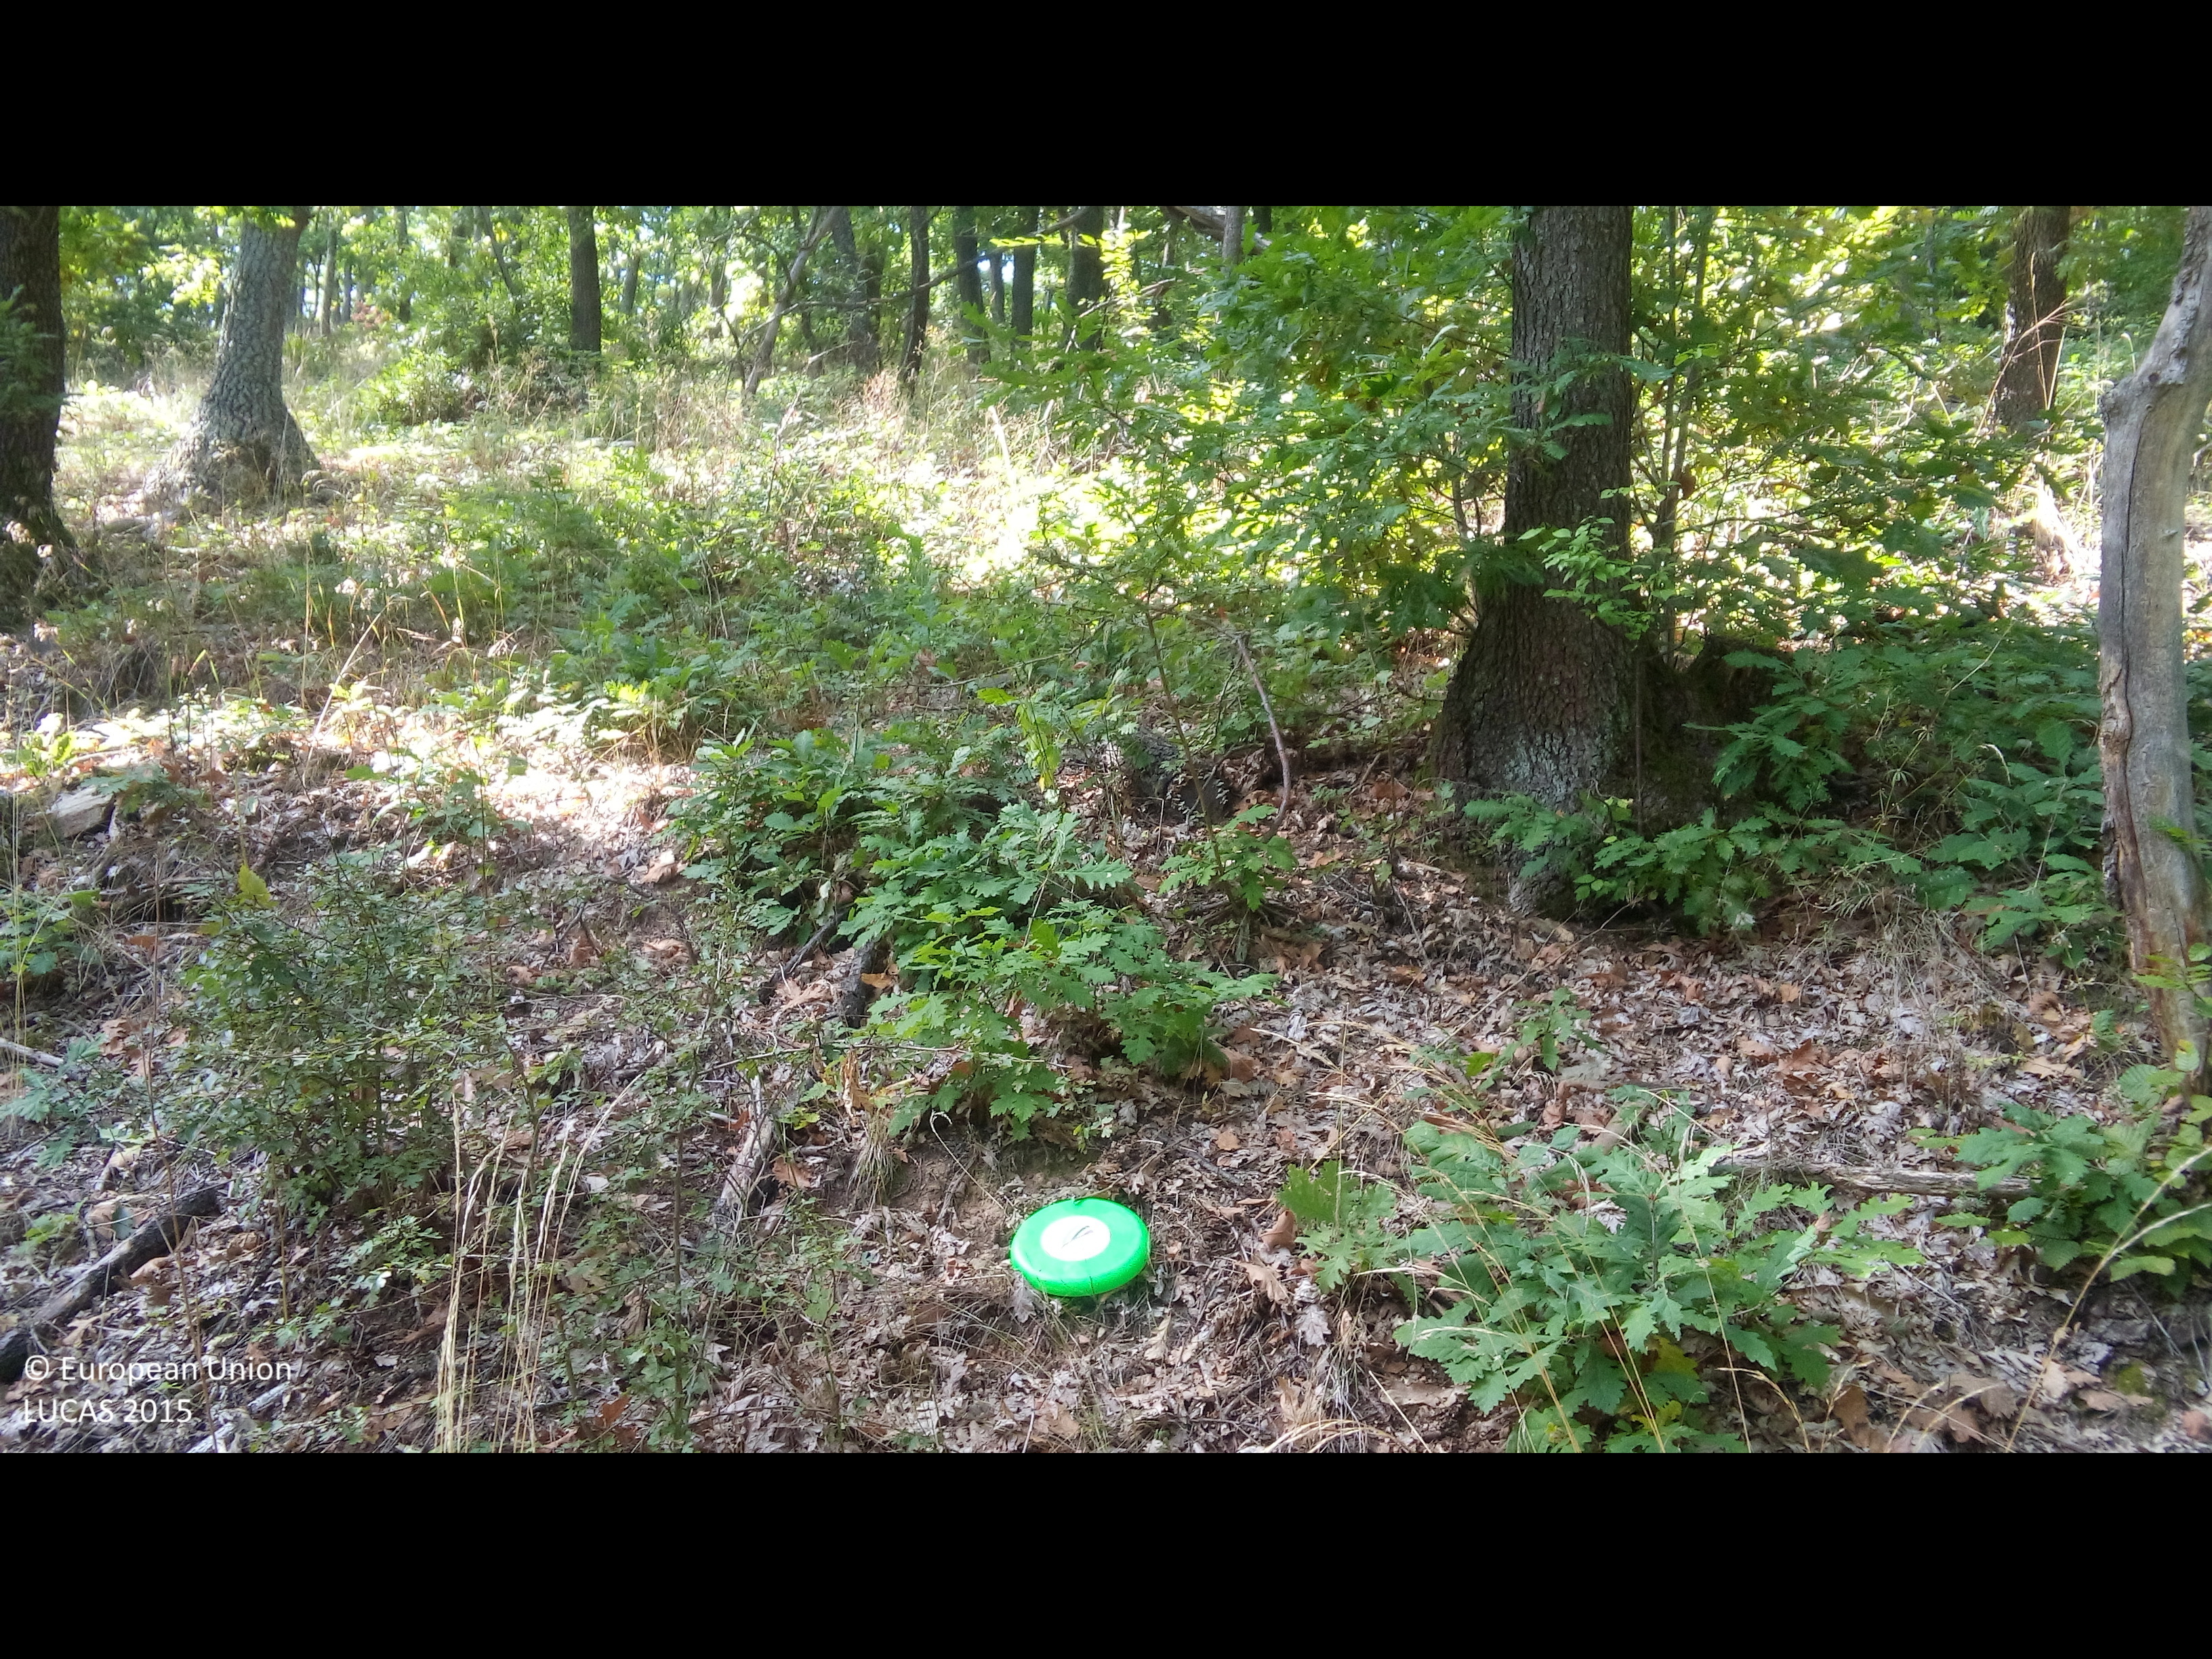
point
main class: Woodland
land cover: Broadleaved woodland
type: mesophytic deciduous forest
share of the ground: > 75 %
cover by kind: broadleaved forest trees 100 %
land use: Forestry
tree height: > 5 m
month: October
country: BG
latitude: 42.7456
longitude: 23.8101
